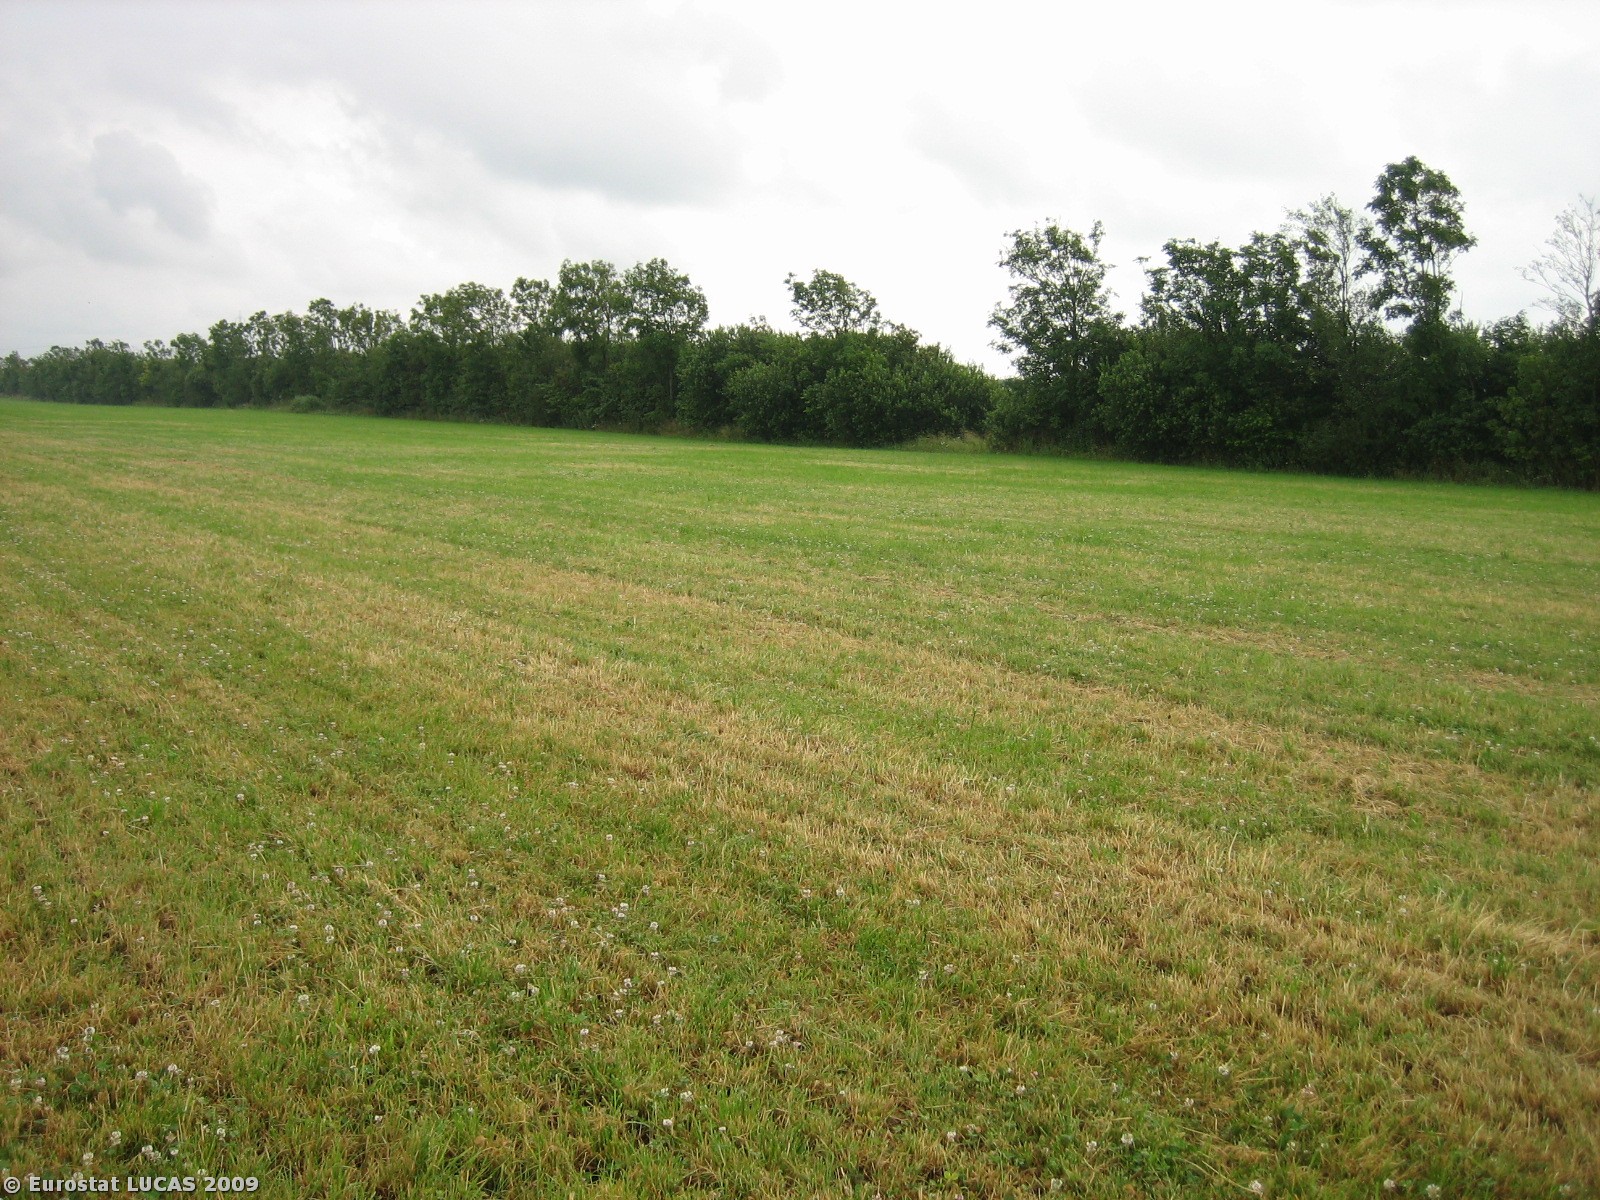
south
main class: Cropland
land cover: Temporary grasslands
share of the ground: > 75 %
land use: Agriculture (excluding fallow land and kitchen gardens)
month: July
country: DK
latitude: 55.4437
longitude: 8.6575
